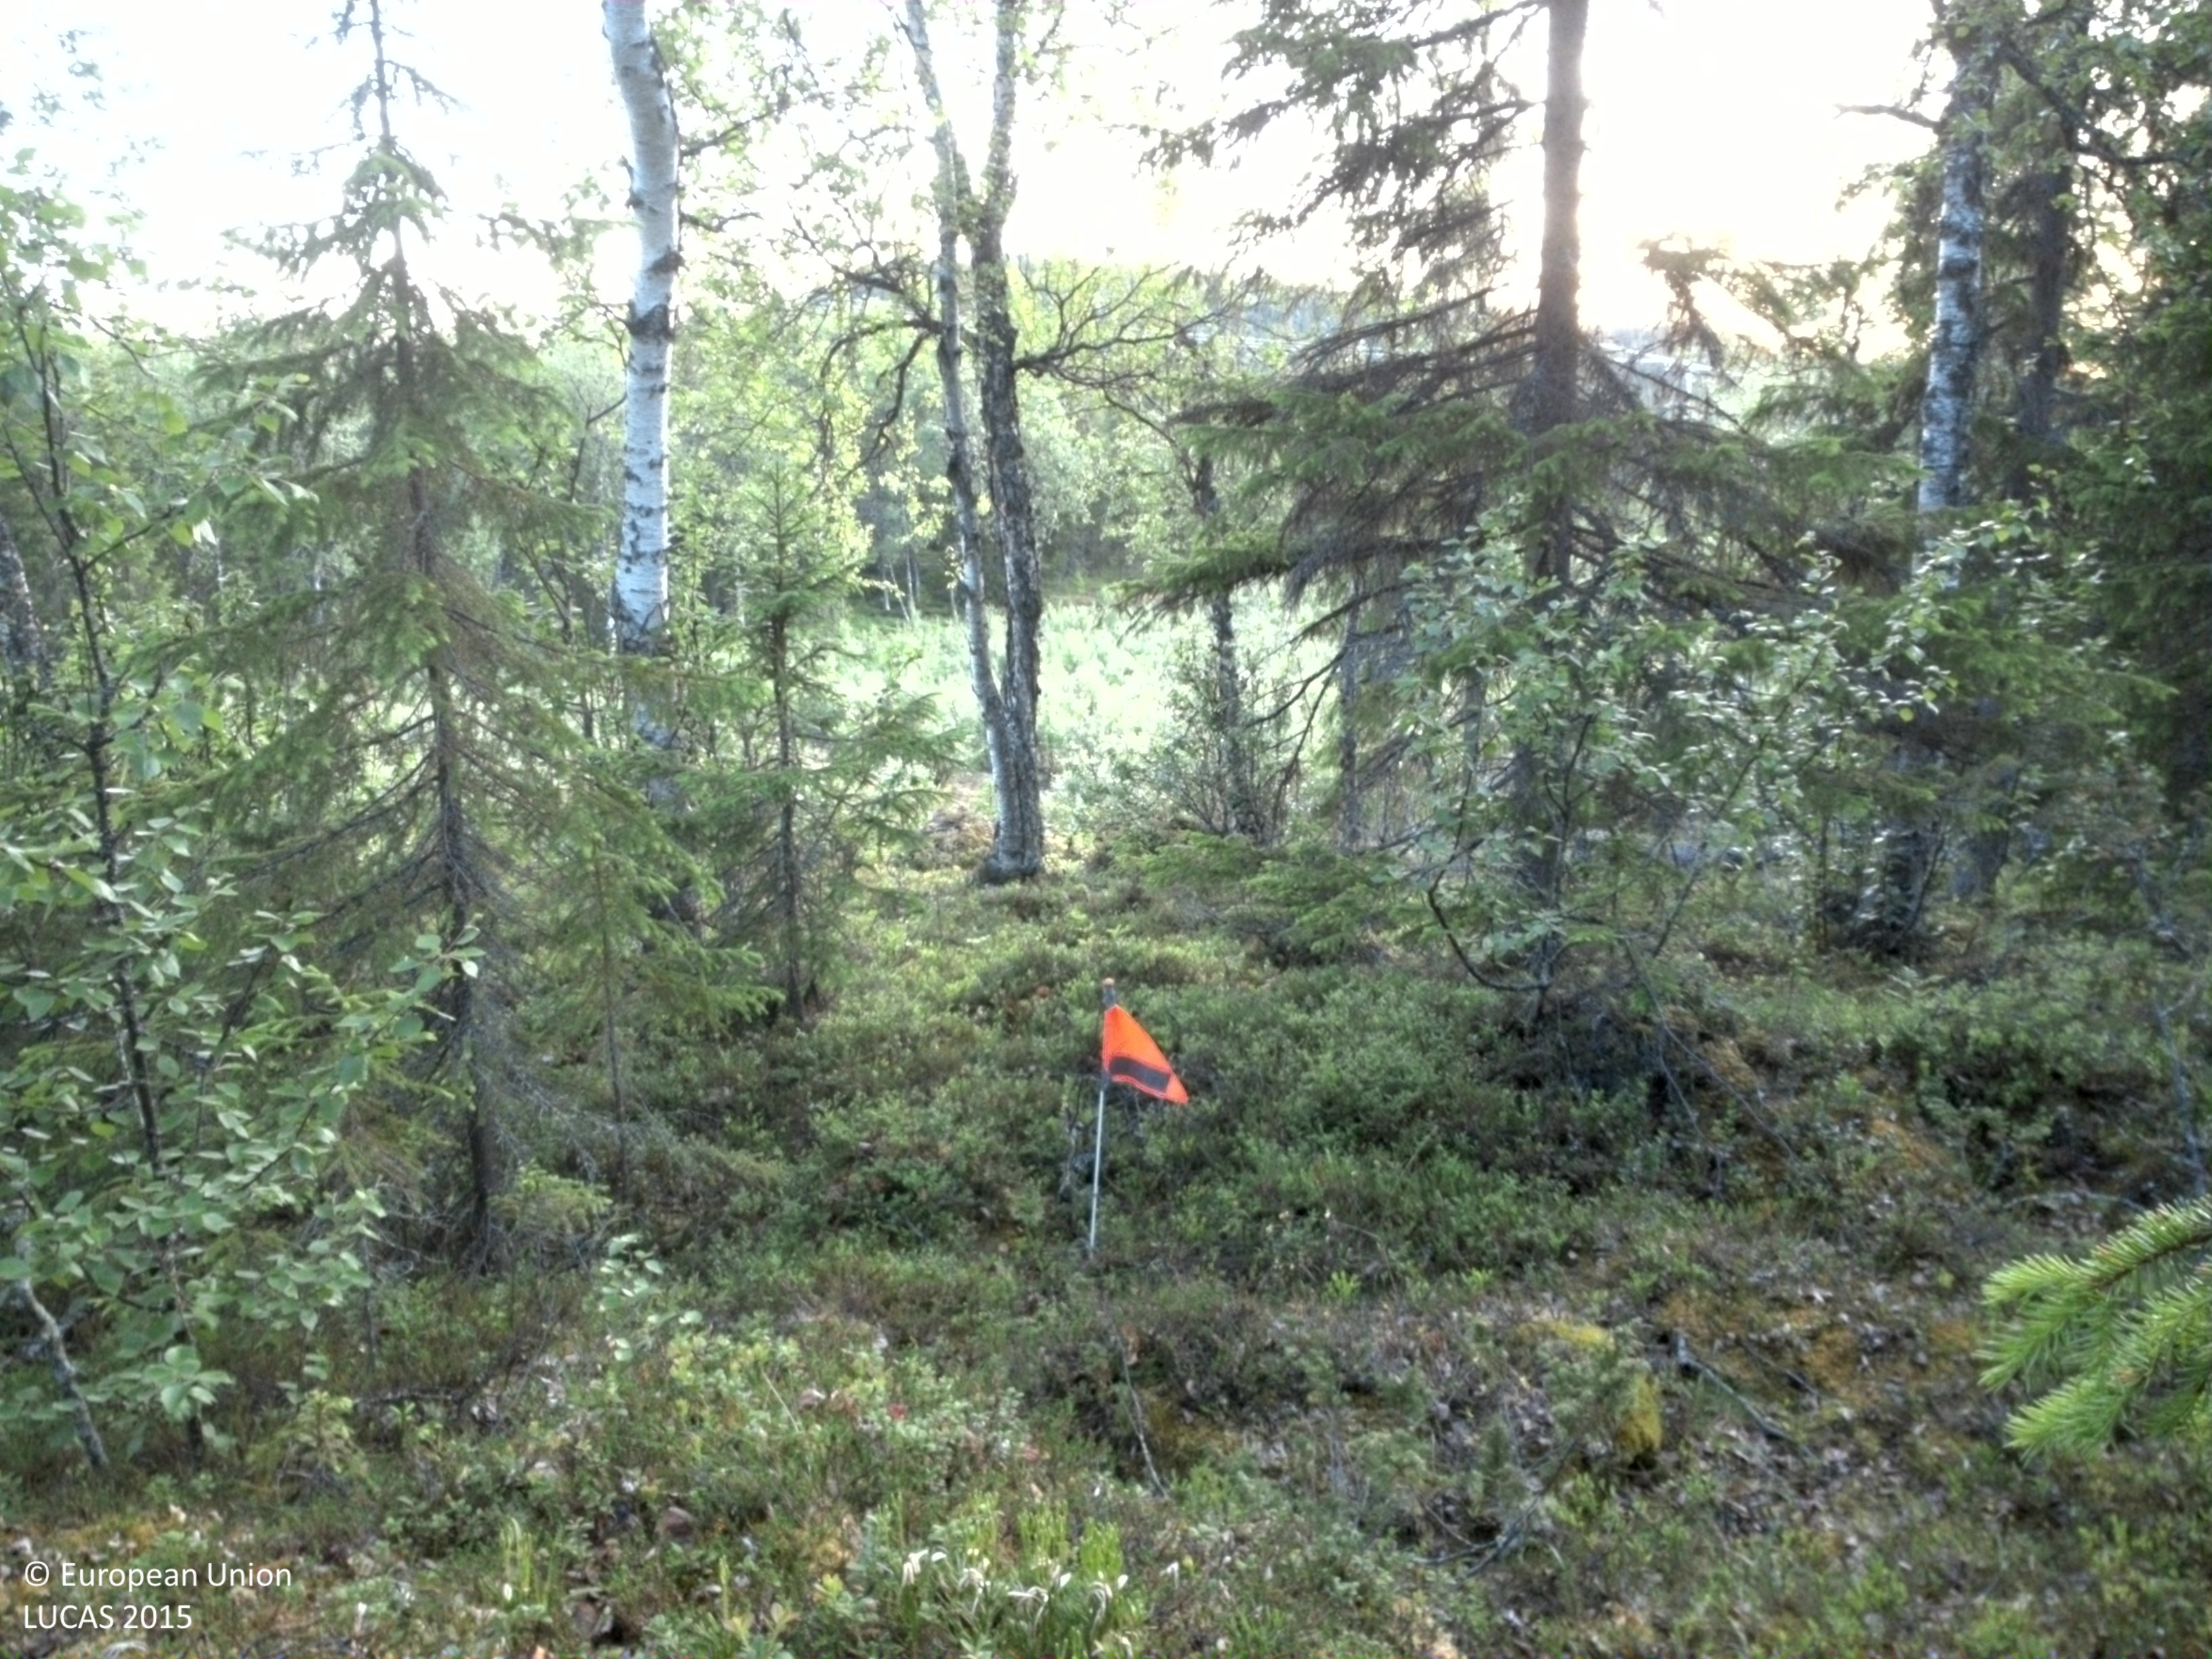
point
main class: Woodland
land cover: Spruce dominated mixed woodland
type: boreal forest
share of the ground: 25 - 50 %
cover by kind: shrubs 45 %, coniferous forest trees 25 %, broadleaved forest trees 20 %, lichens and mosses 10 %
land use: Forestry
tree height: > 5 m
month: July
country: SE
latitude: 65.5365
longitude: 15.4400
